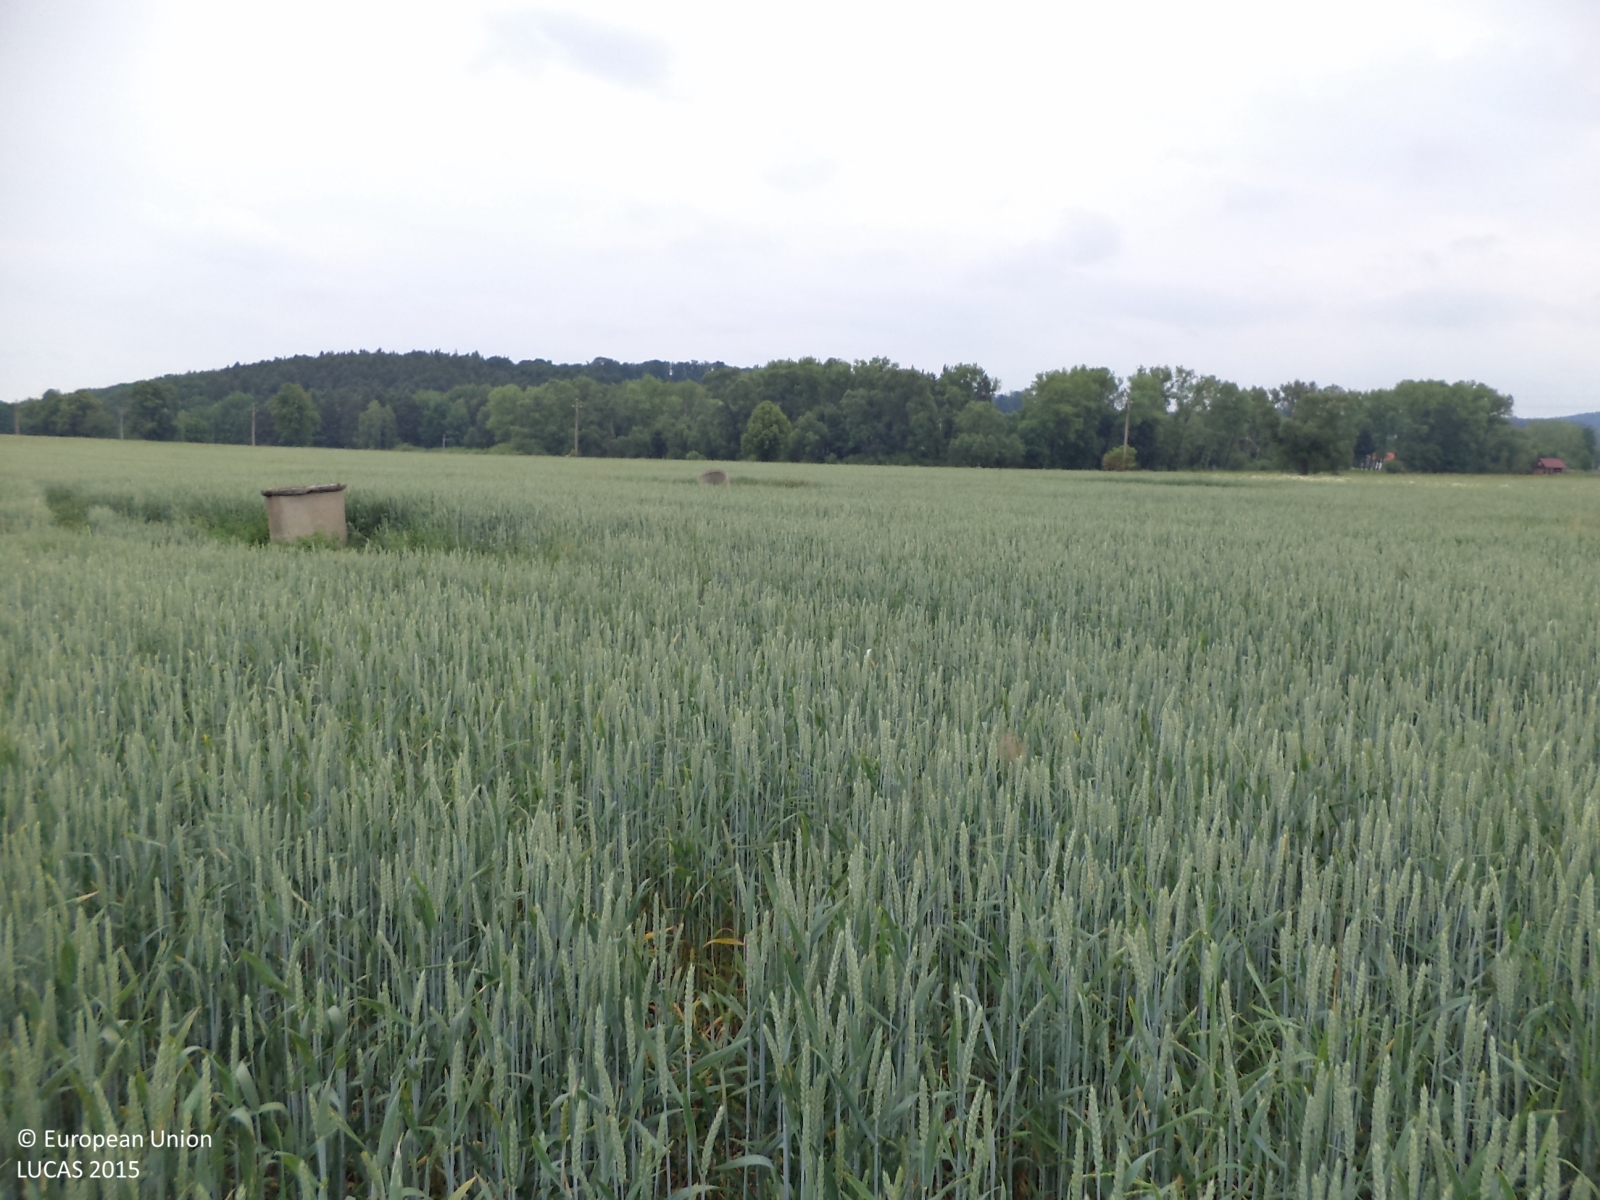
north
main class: Cropland
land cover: Common wheat
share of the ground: > 75 %
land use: Agriculture (excluding fallow land and kitchen gardens)
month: June
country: CZ
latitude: 49.1859
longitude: 14.2679
